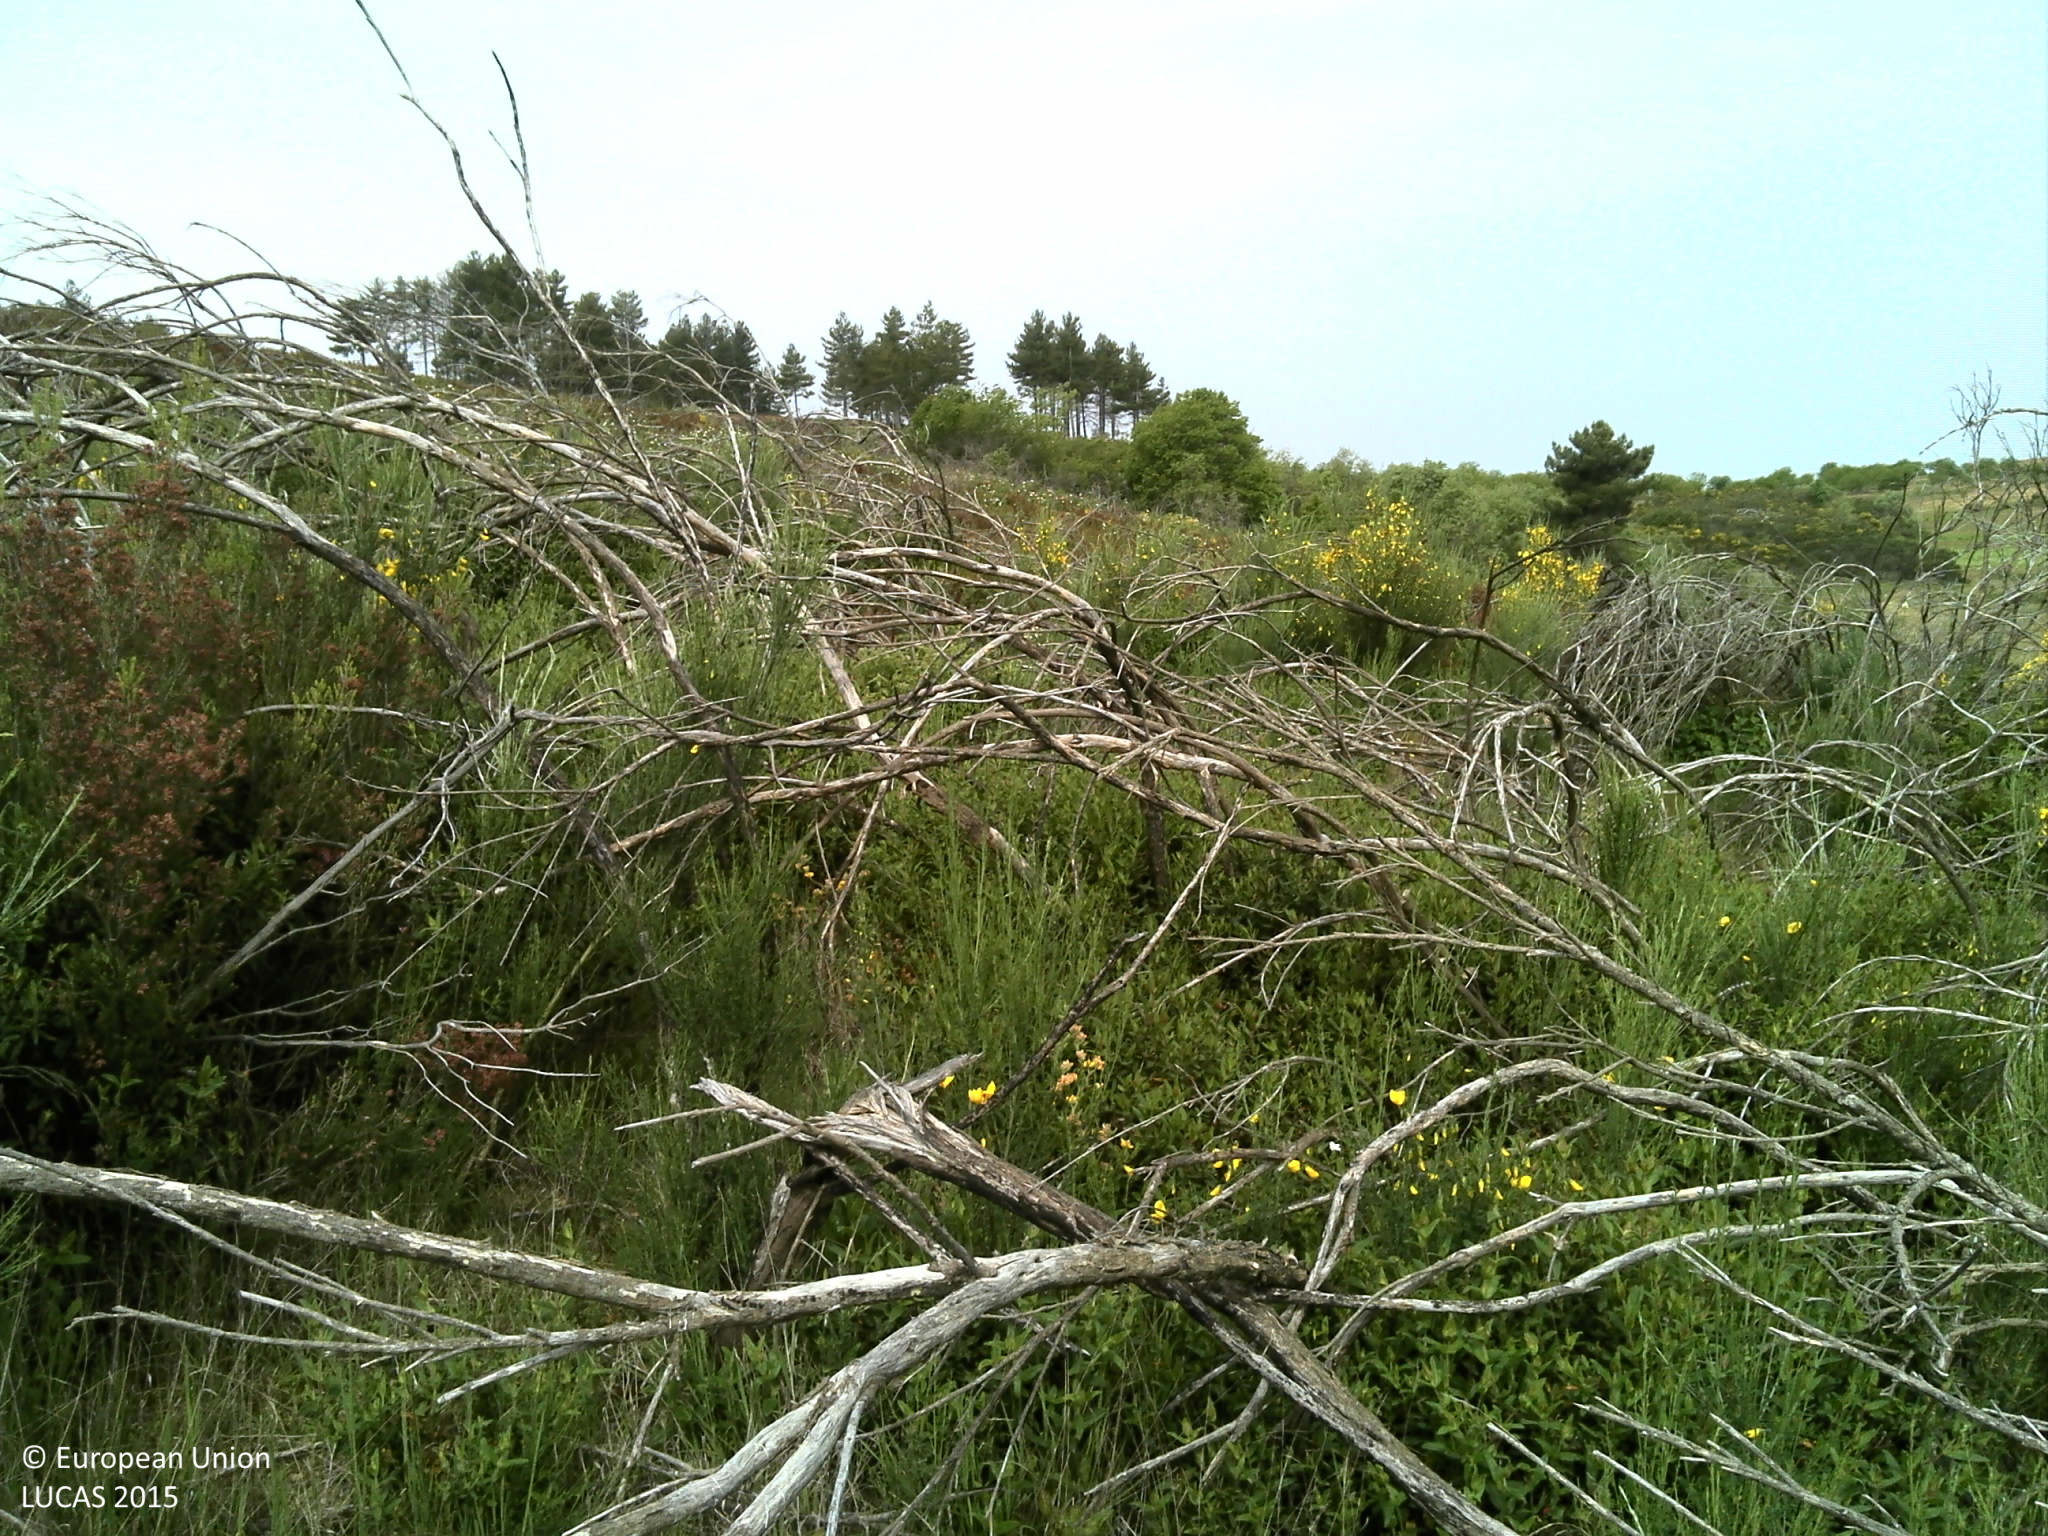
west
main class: Shrubland
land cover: Shrubland without tree cover
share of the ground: > 75 %
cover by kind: shrubs 75 %, herbaceous plants 15 %, unconsolidated bare surface 10 %
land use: Abandoned areas
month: May
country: PT
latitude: 41.6745
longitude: -6.9443
